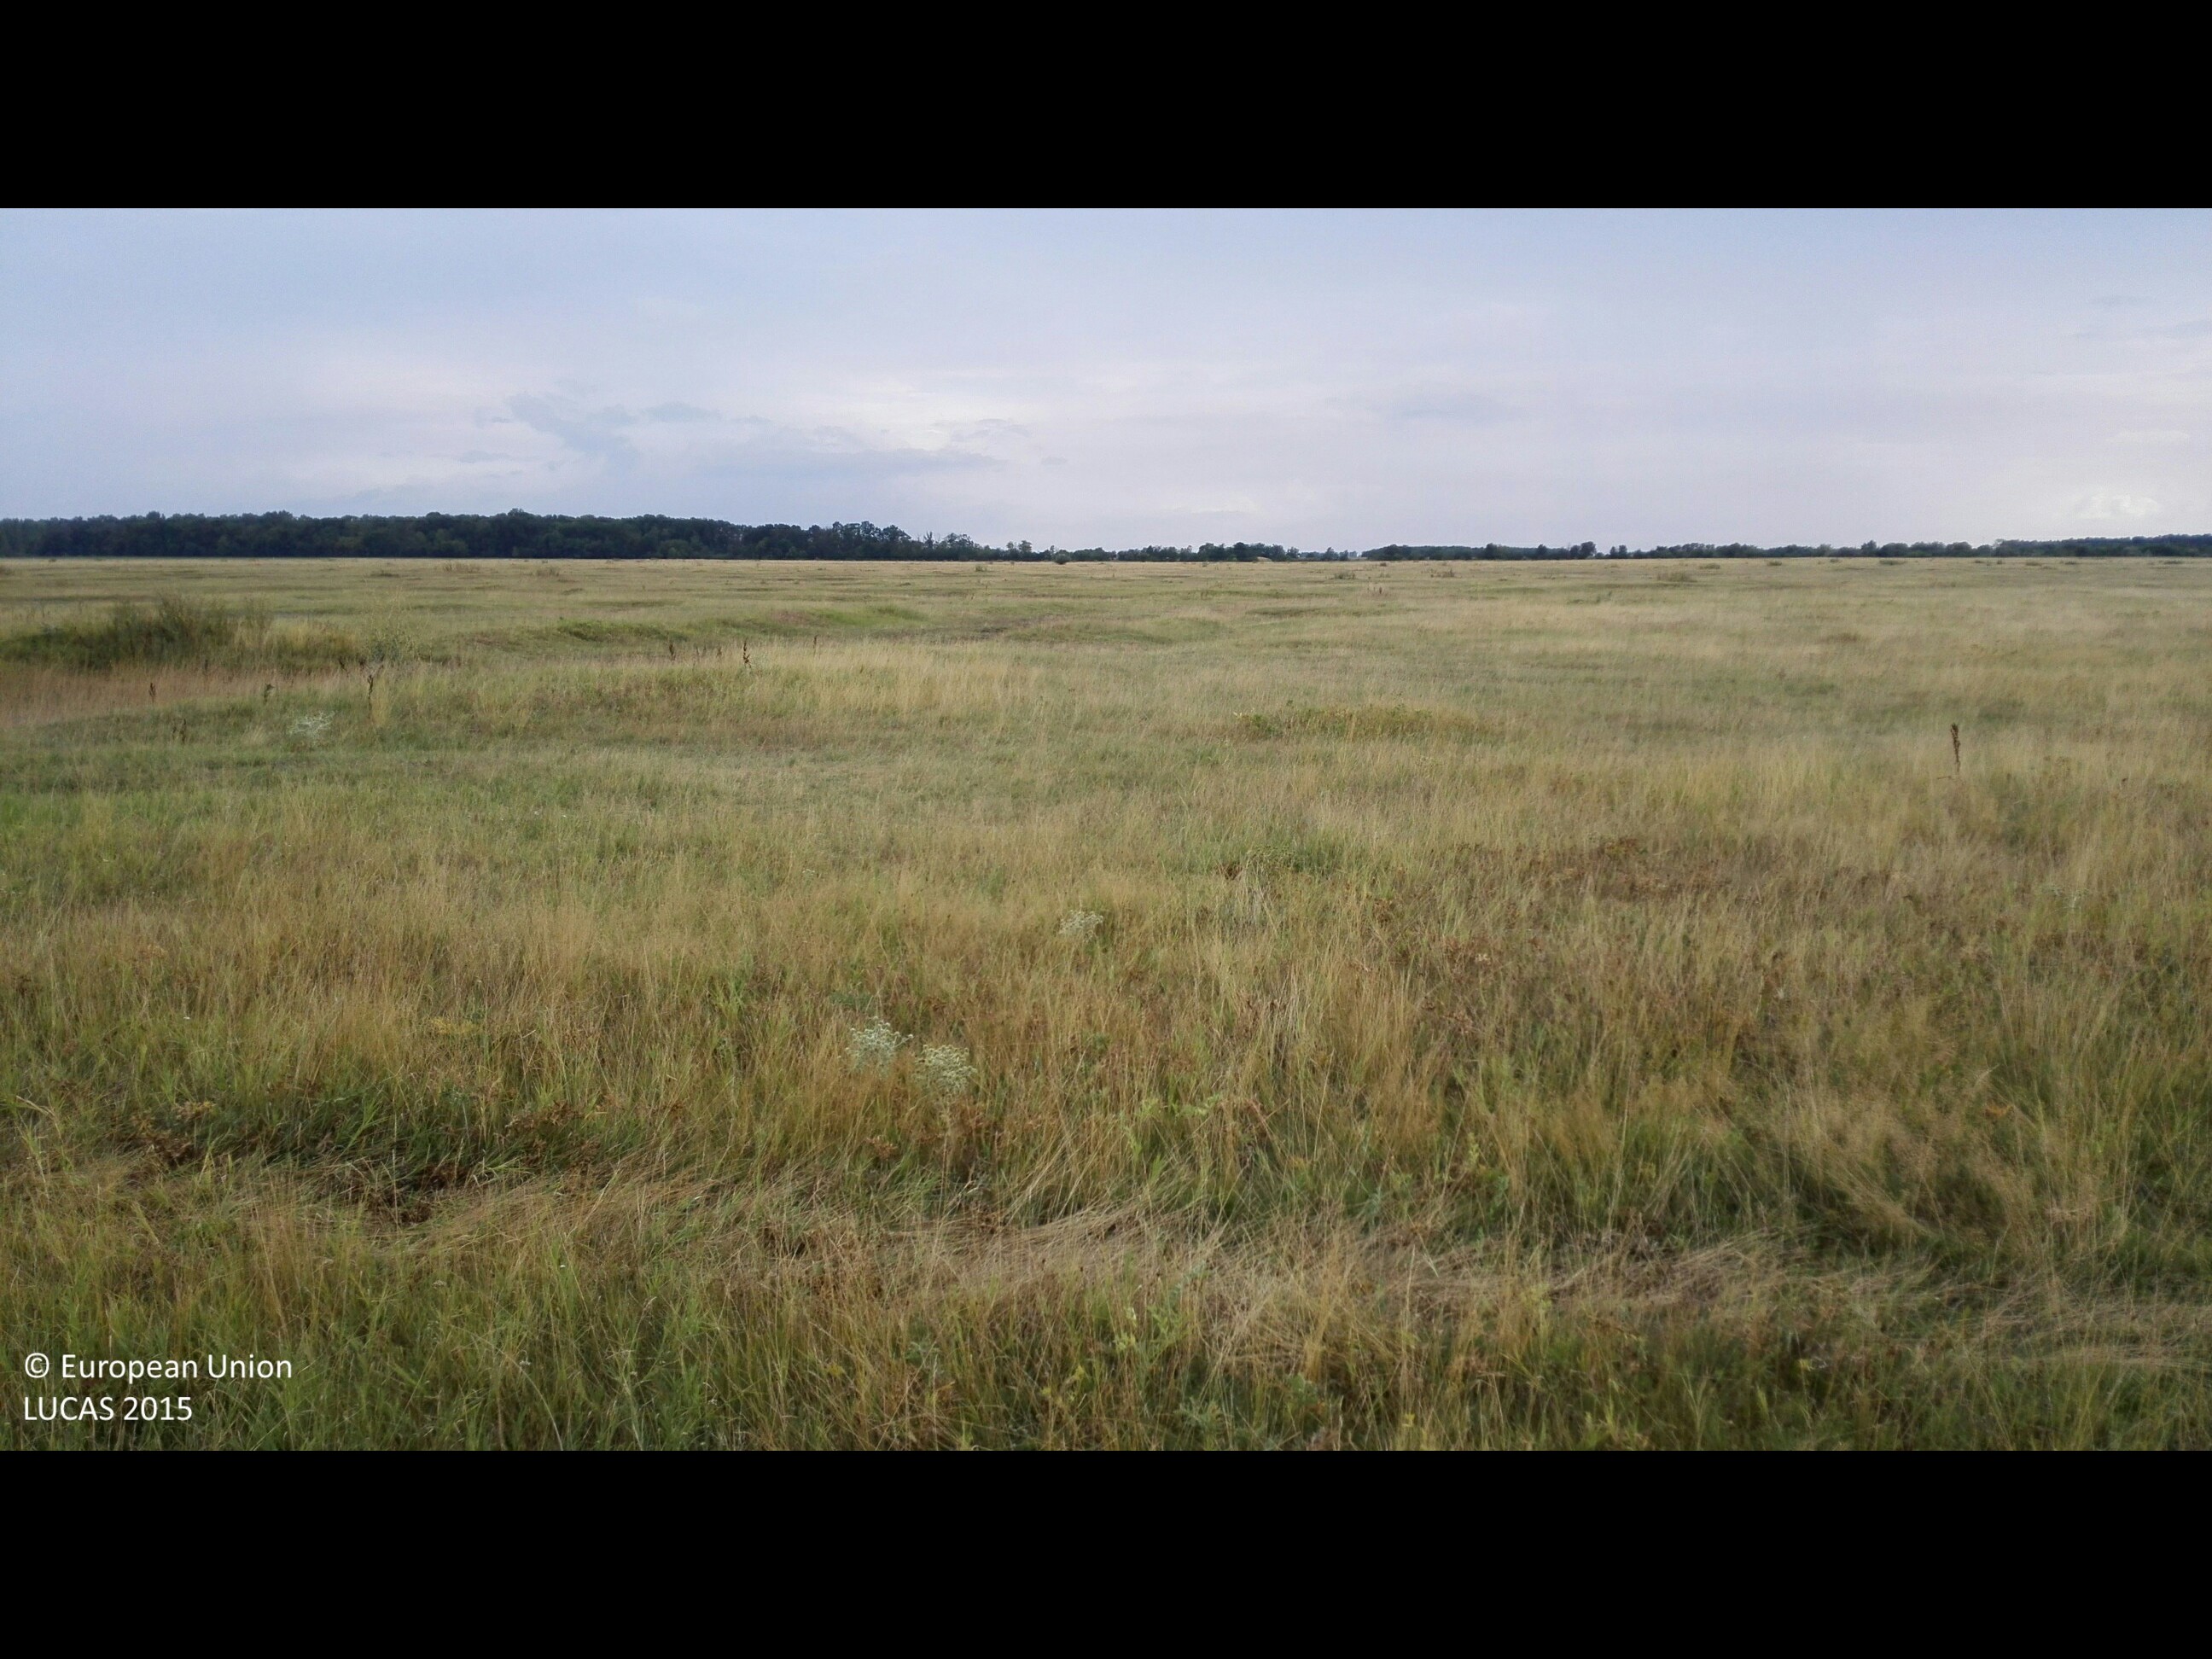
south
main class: Grassland
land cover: Grassland without tree/shrub cover
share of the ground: > 75 %
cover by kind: herbaceous plants 100 %
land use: Agriculture (excluding fallow land and kitchen gardens)
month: August
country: HU
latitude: 47.3365
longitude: 21.5968
